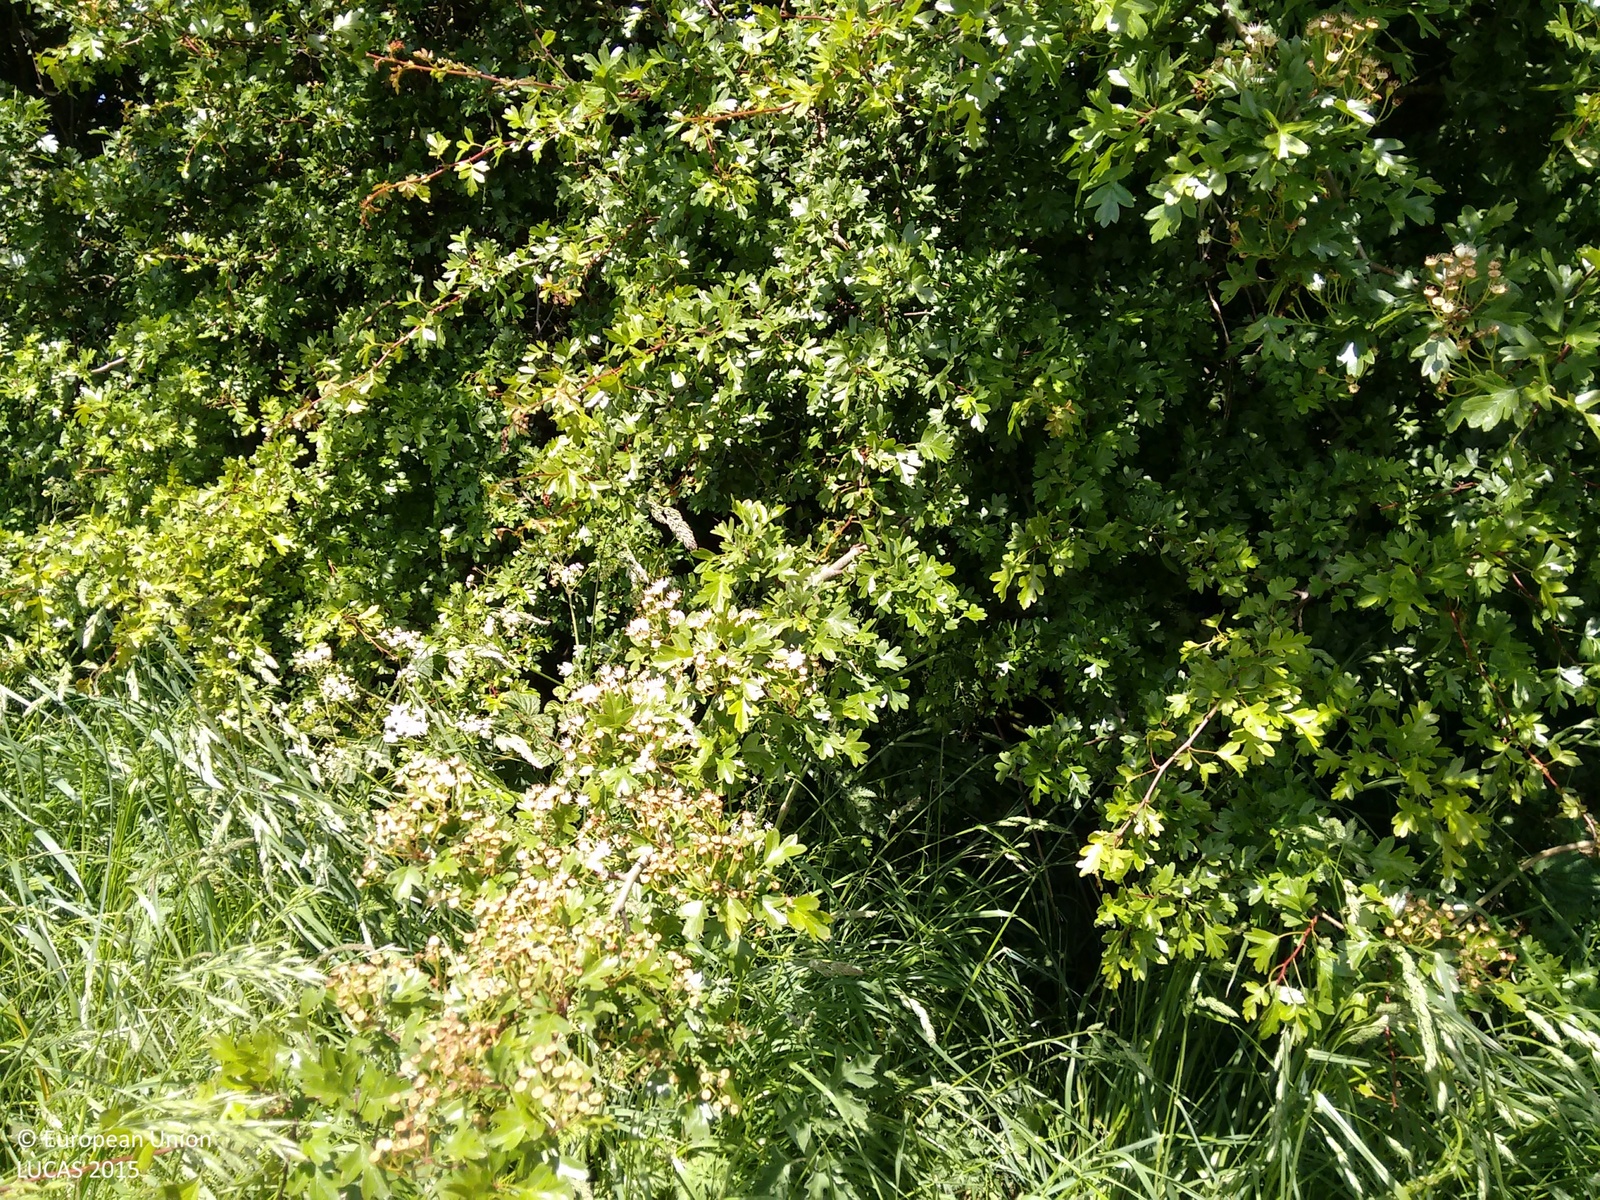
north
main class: Cropland
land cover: Barley
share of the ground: > 75 %
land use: Agriculture (excluding fallow land and kitchen gardens)
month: June
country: GB
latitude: 52.4473
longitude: -1.3635
